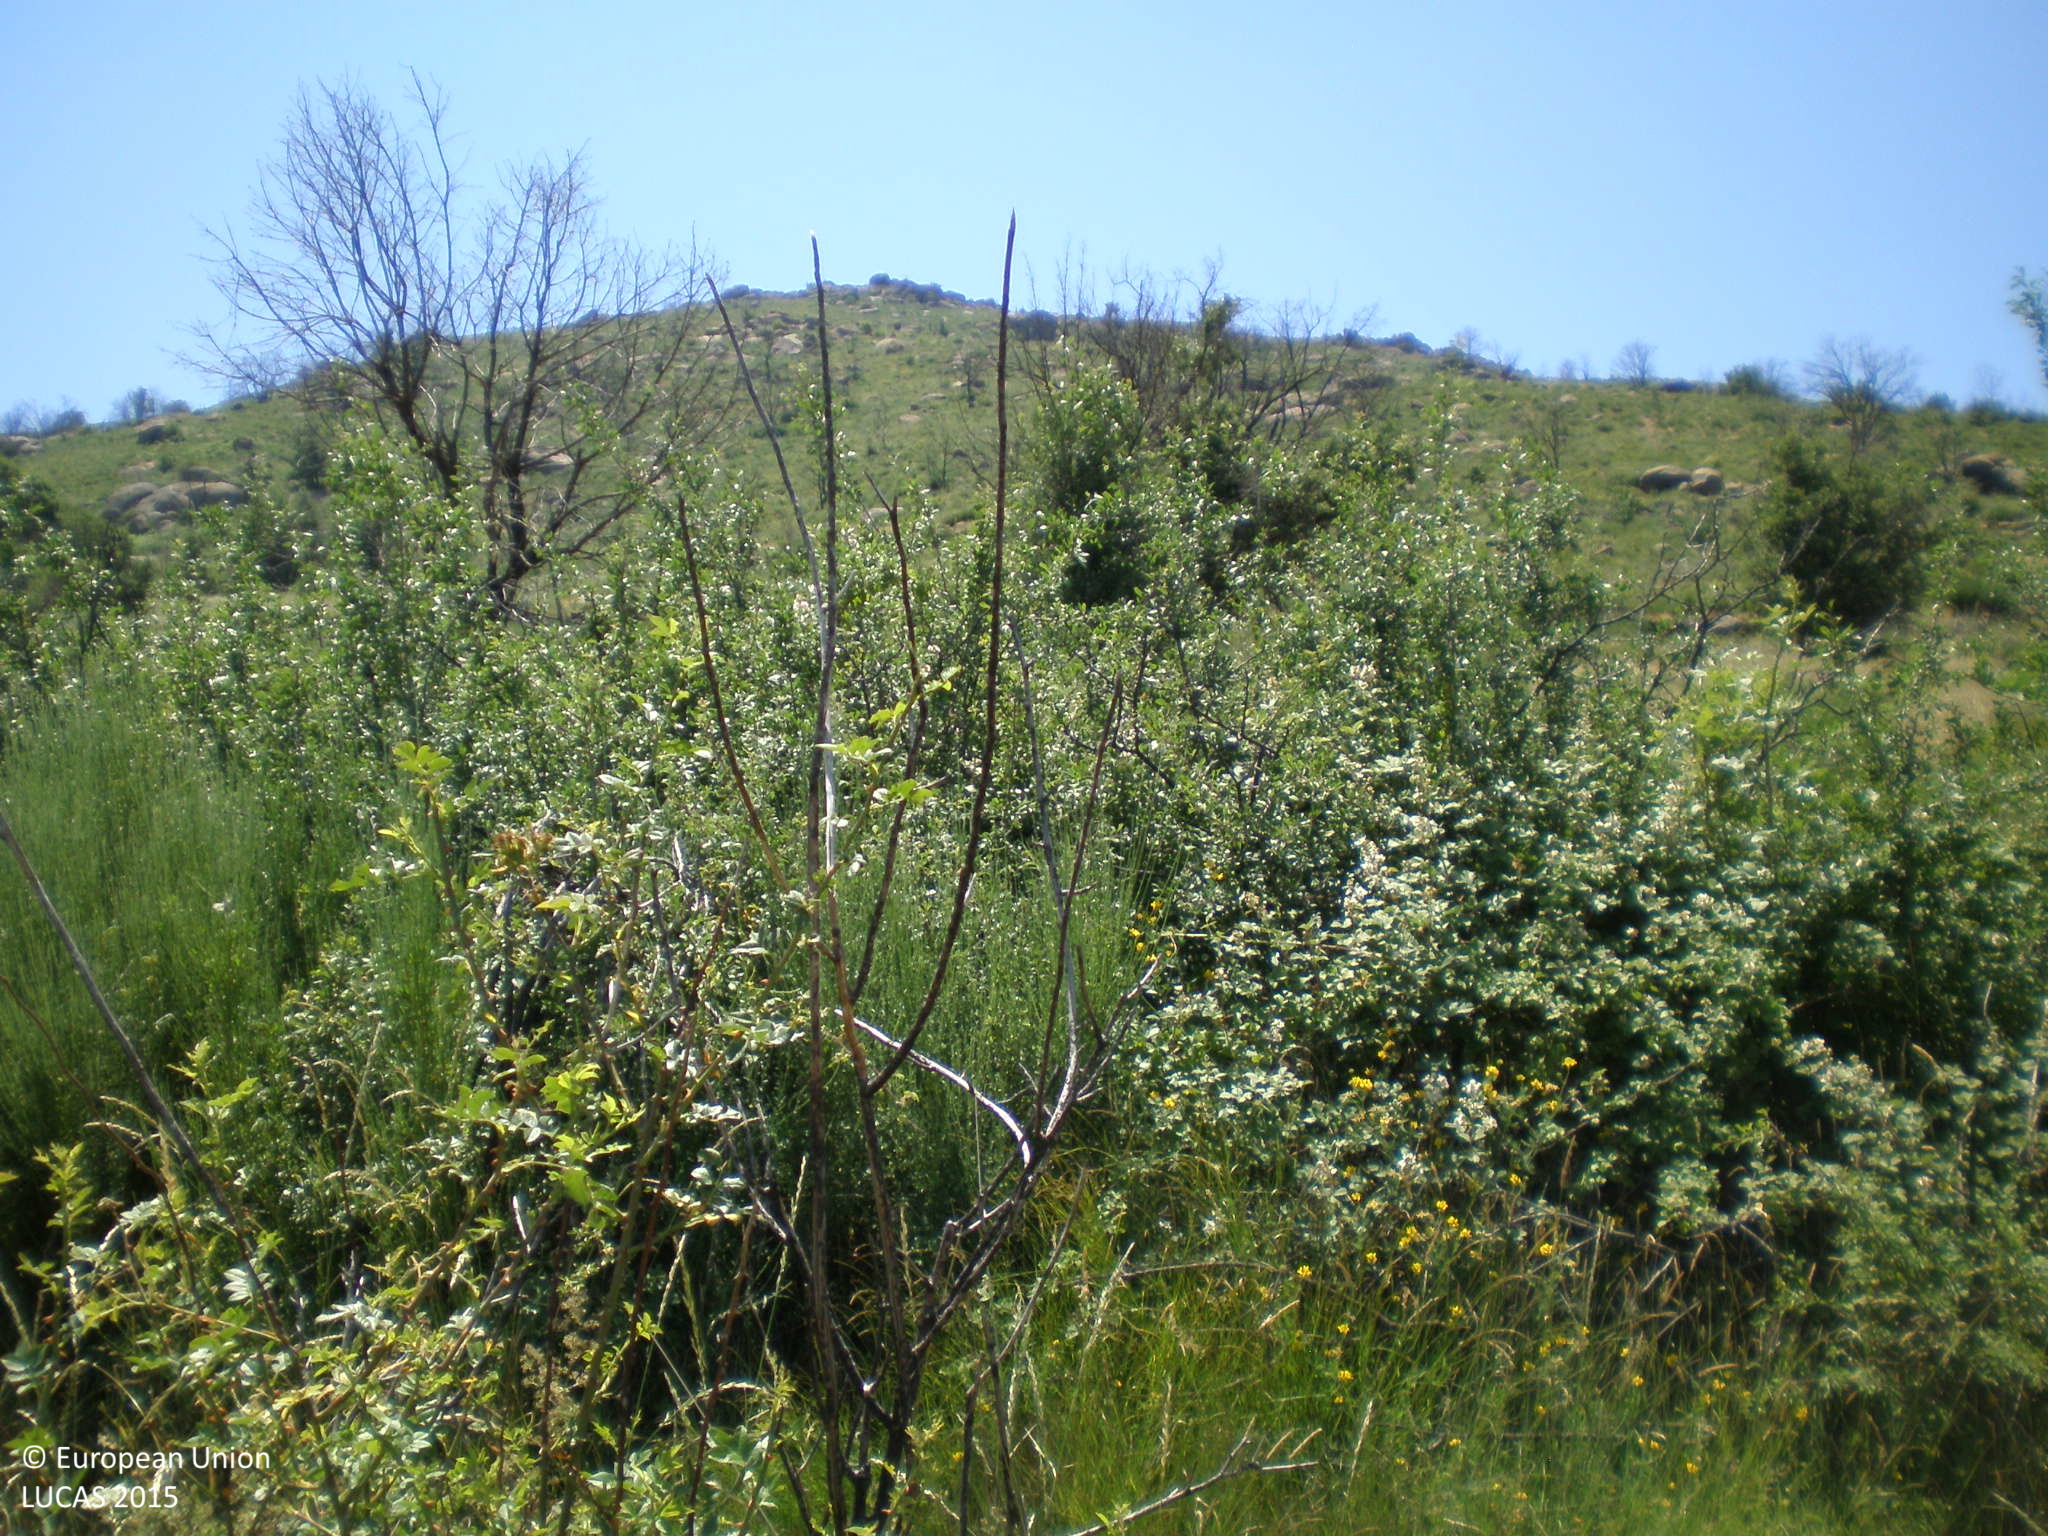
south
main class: Shrubland
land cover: Shrubland without tree cover
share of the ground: 50 - 75 %
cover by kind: shrubs 70 %, herbaceous plants 30 %
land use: Semi-natural and natural areas not in use
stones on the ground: < 10 %
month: June
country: ES
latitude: 40.3924
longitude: -5.5828
